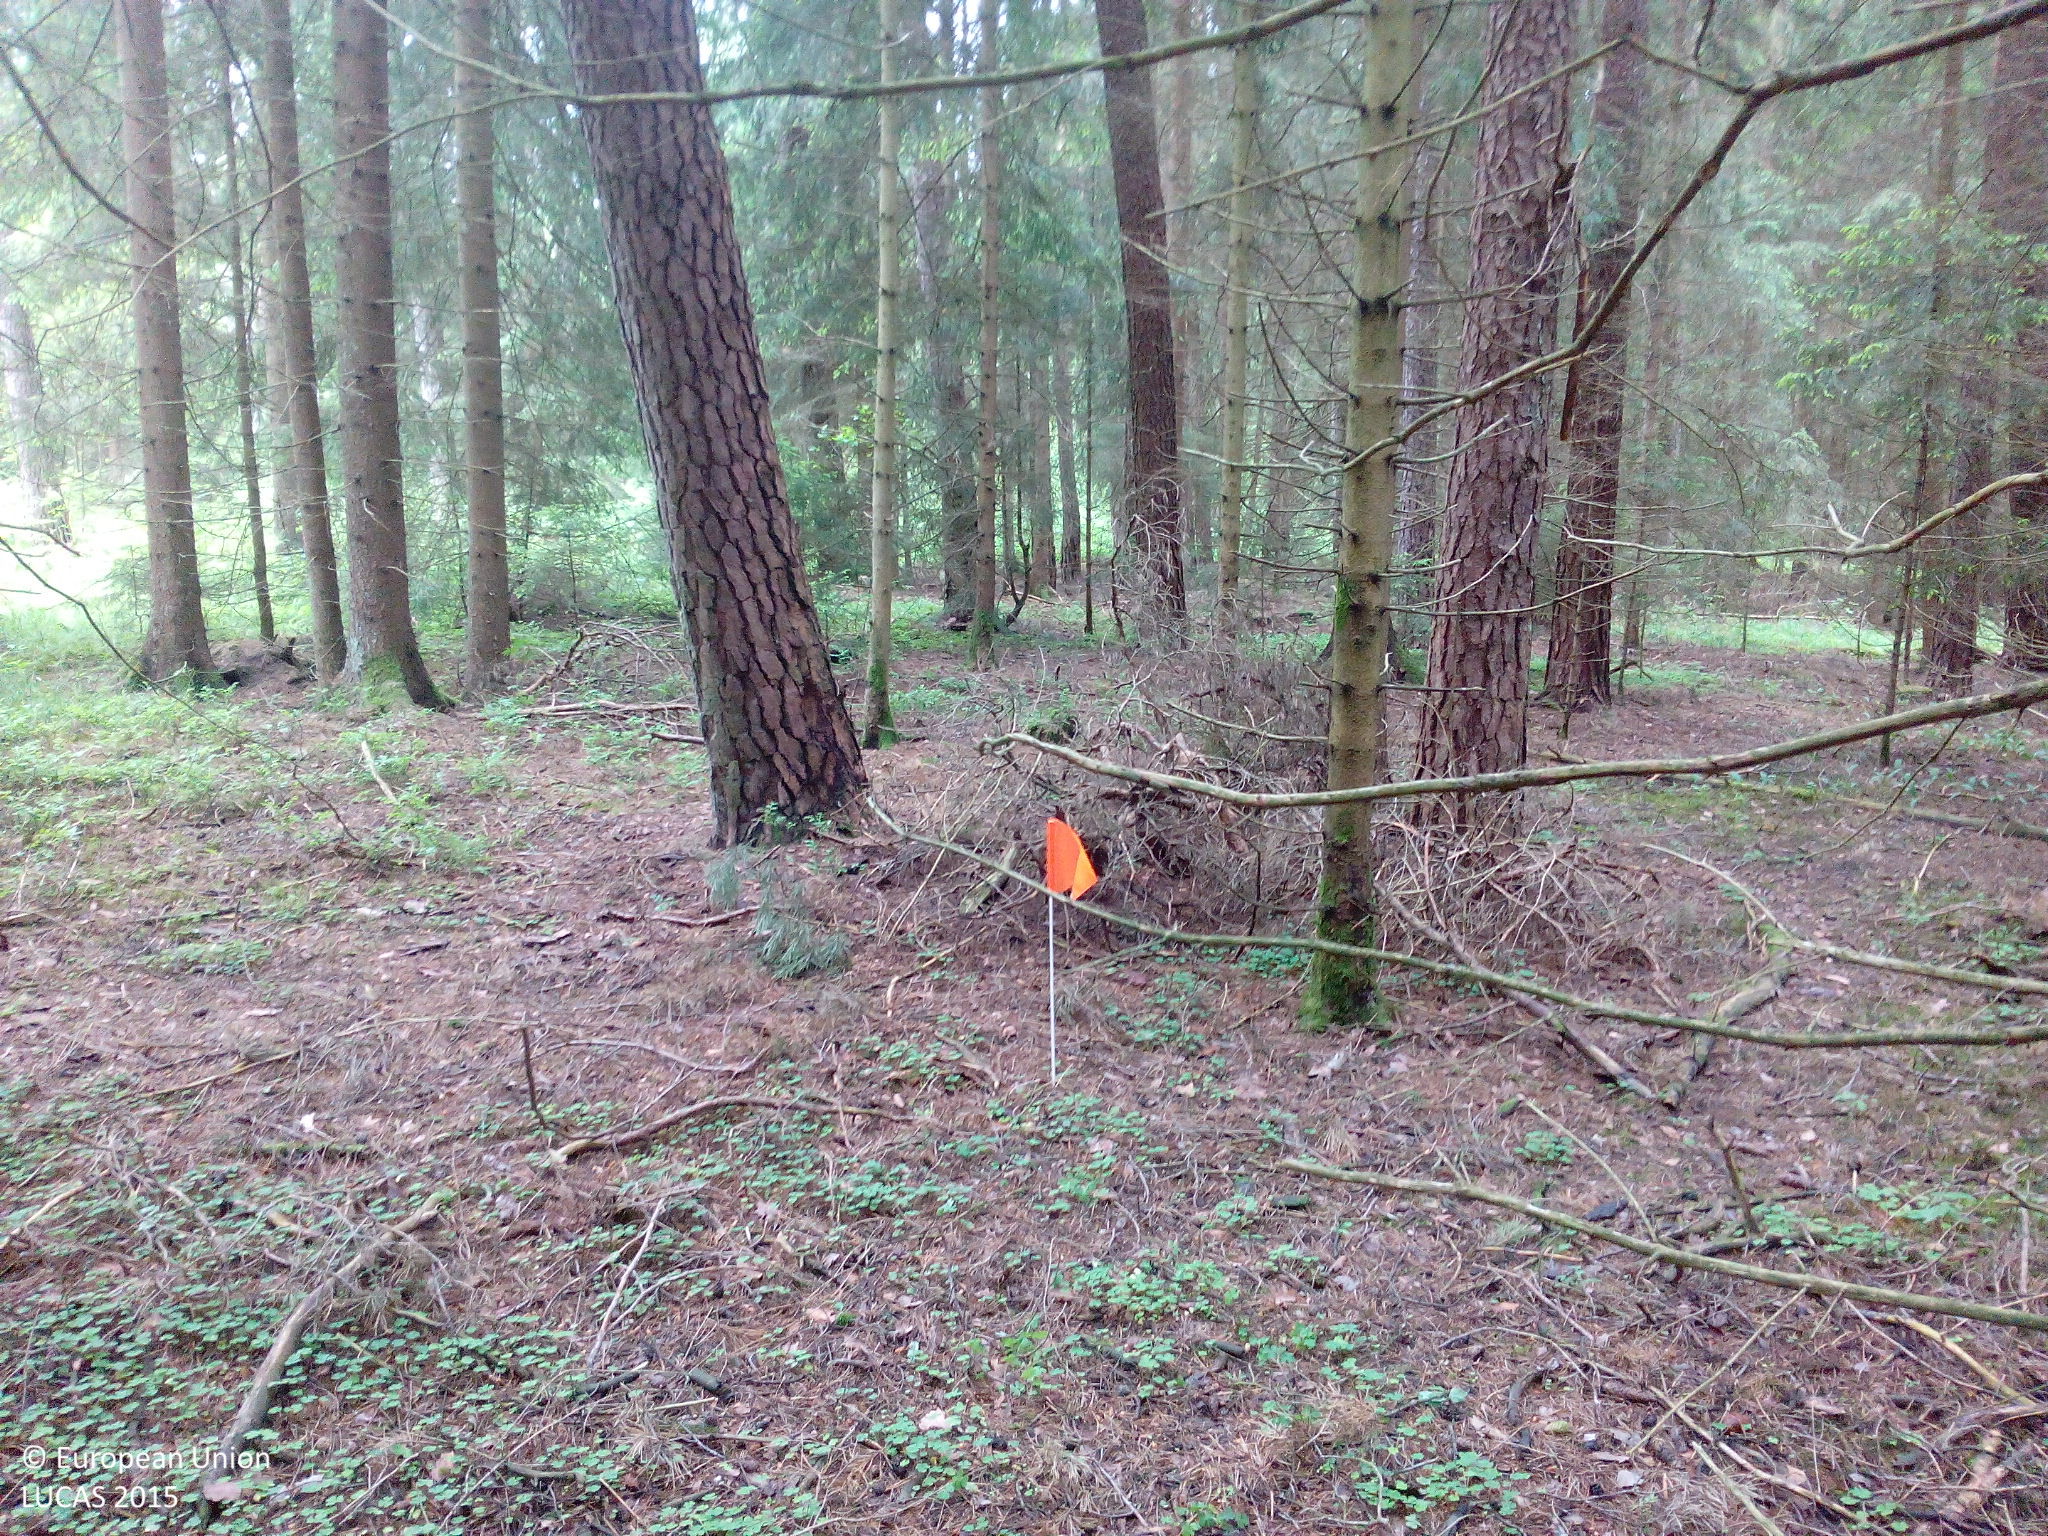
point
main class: Woodland
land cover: Other coniferous woodland
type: hemiboreal forest and nemoral coniferous forest and mixed broadleaved-coniferous forest
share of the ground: > 75 %
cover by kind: coniferous forest trees 80 %, lichens and mosses 10 %, unconsolidated bare surface 10 %
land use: Forestry
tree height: > 5 m
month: June
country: DE
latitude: 49.2964
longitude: 12.3509
